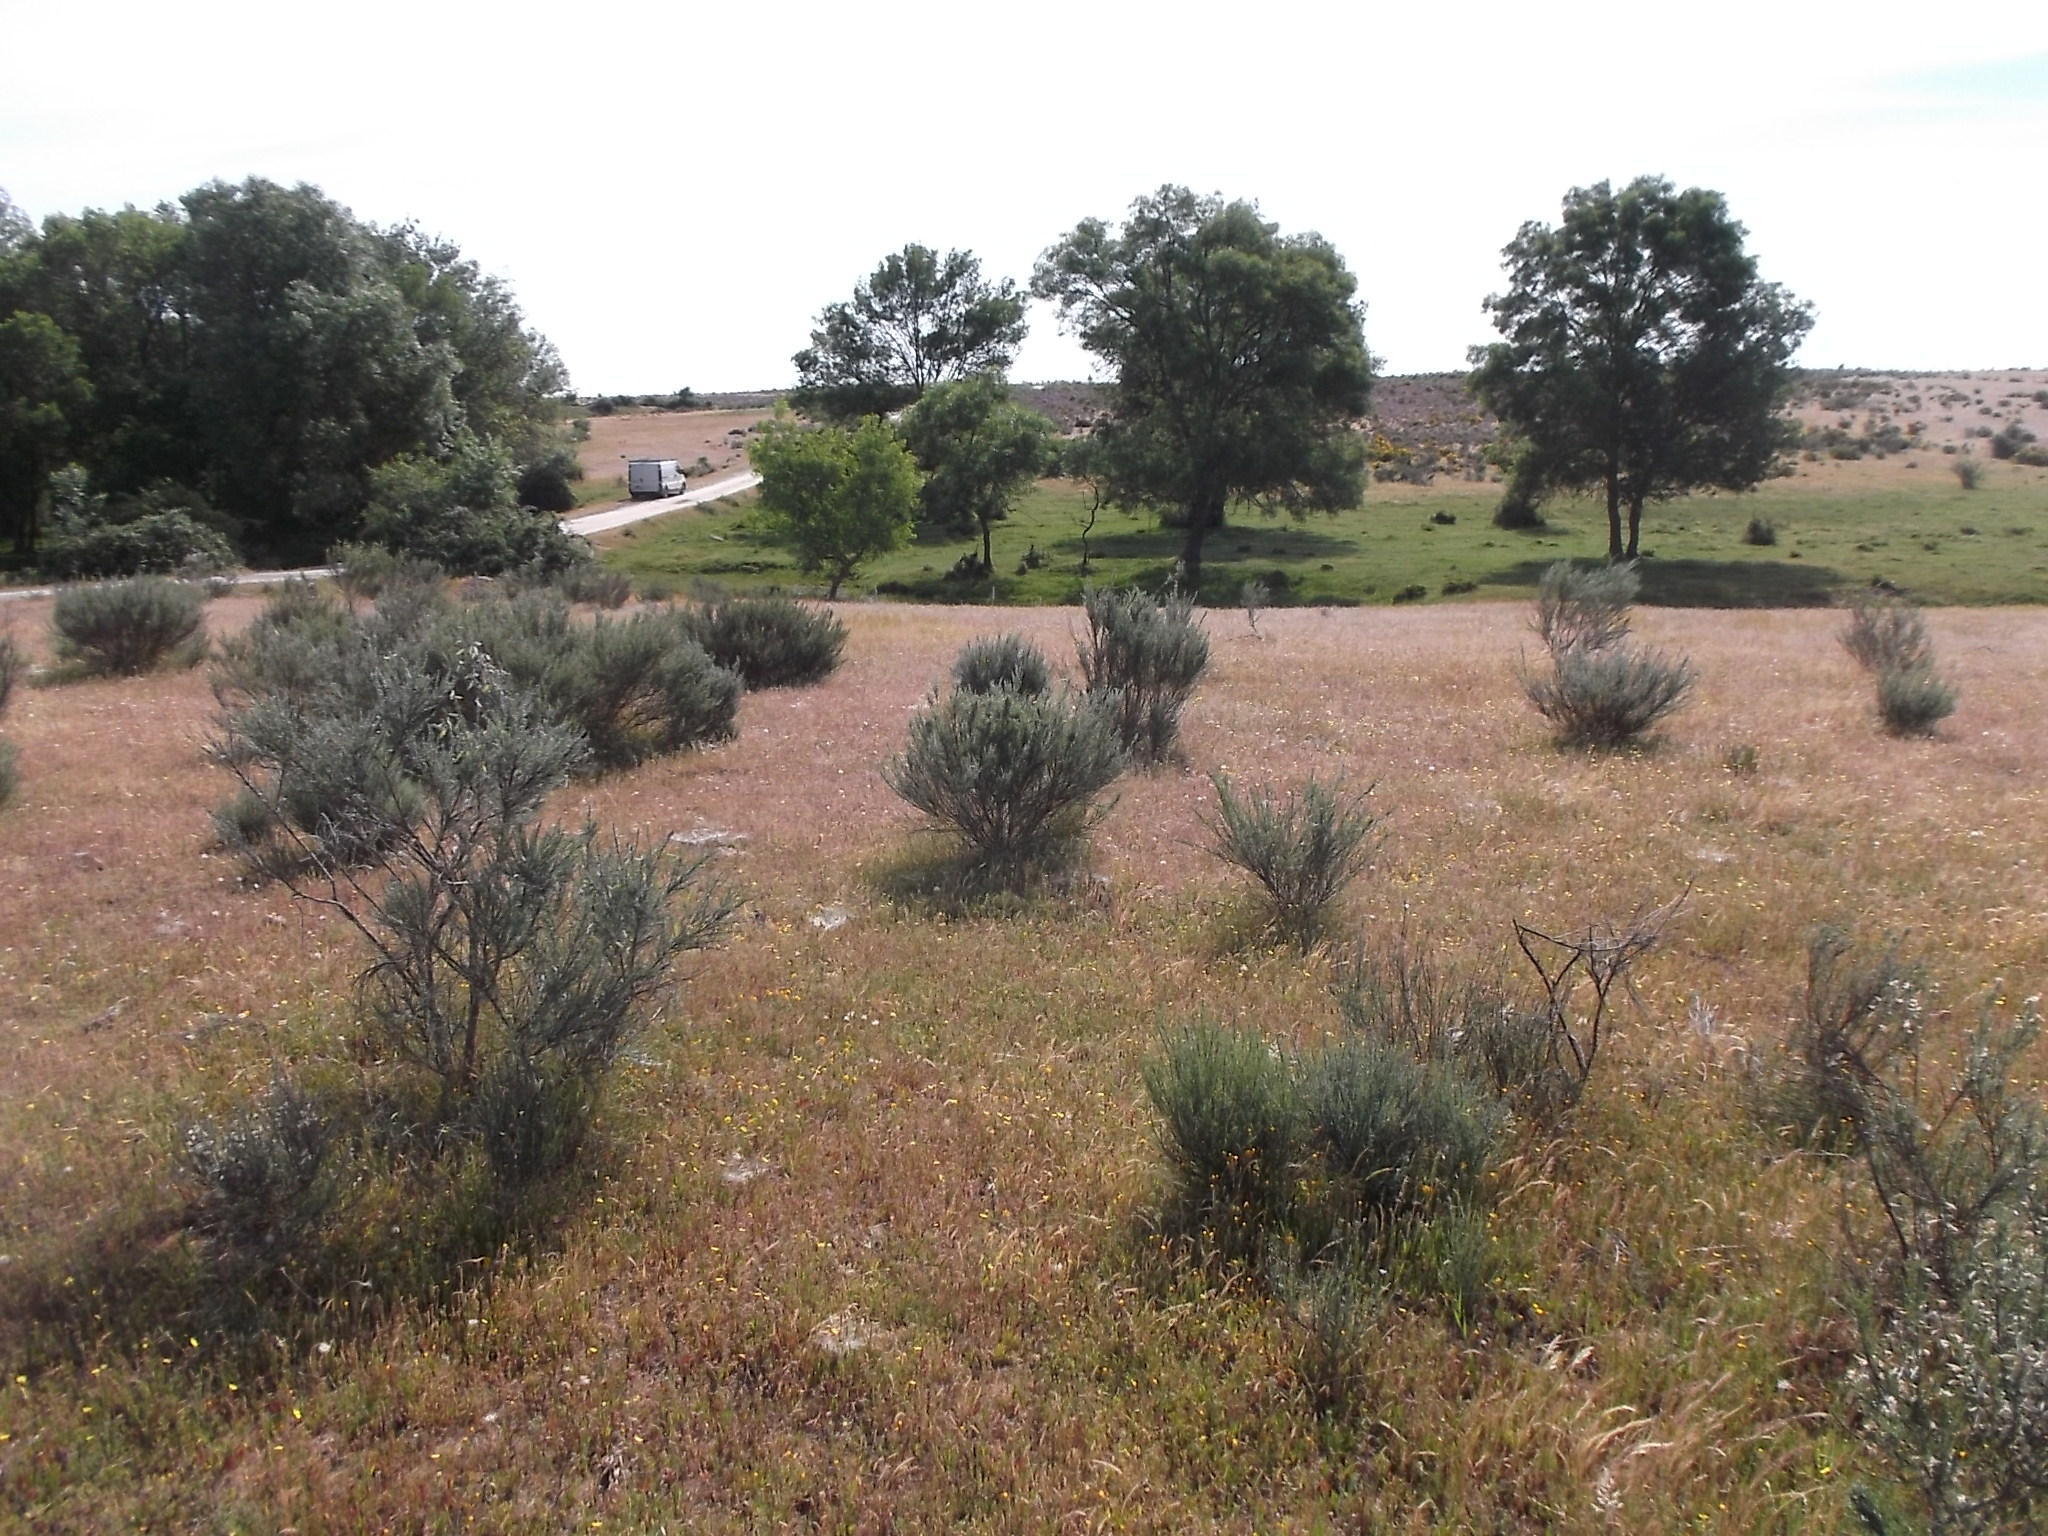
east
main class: Shrubland
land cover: Shrubland without tree cover
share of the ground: 50 - 75 %
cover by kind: shrubs 70 %, herbaceous plants 30 %
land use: Semi-natural and natural areas not in use
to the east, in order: Shrubland without tree cover; Grassland without tree/shrub cover; Inland fresh running water; Broadleaved woodland; Grassland without tree/shrub cover; Shrubland without tree cover
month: May
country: ES
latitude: 41.0130
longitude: -6.3955
